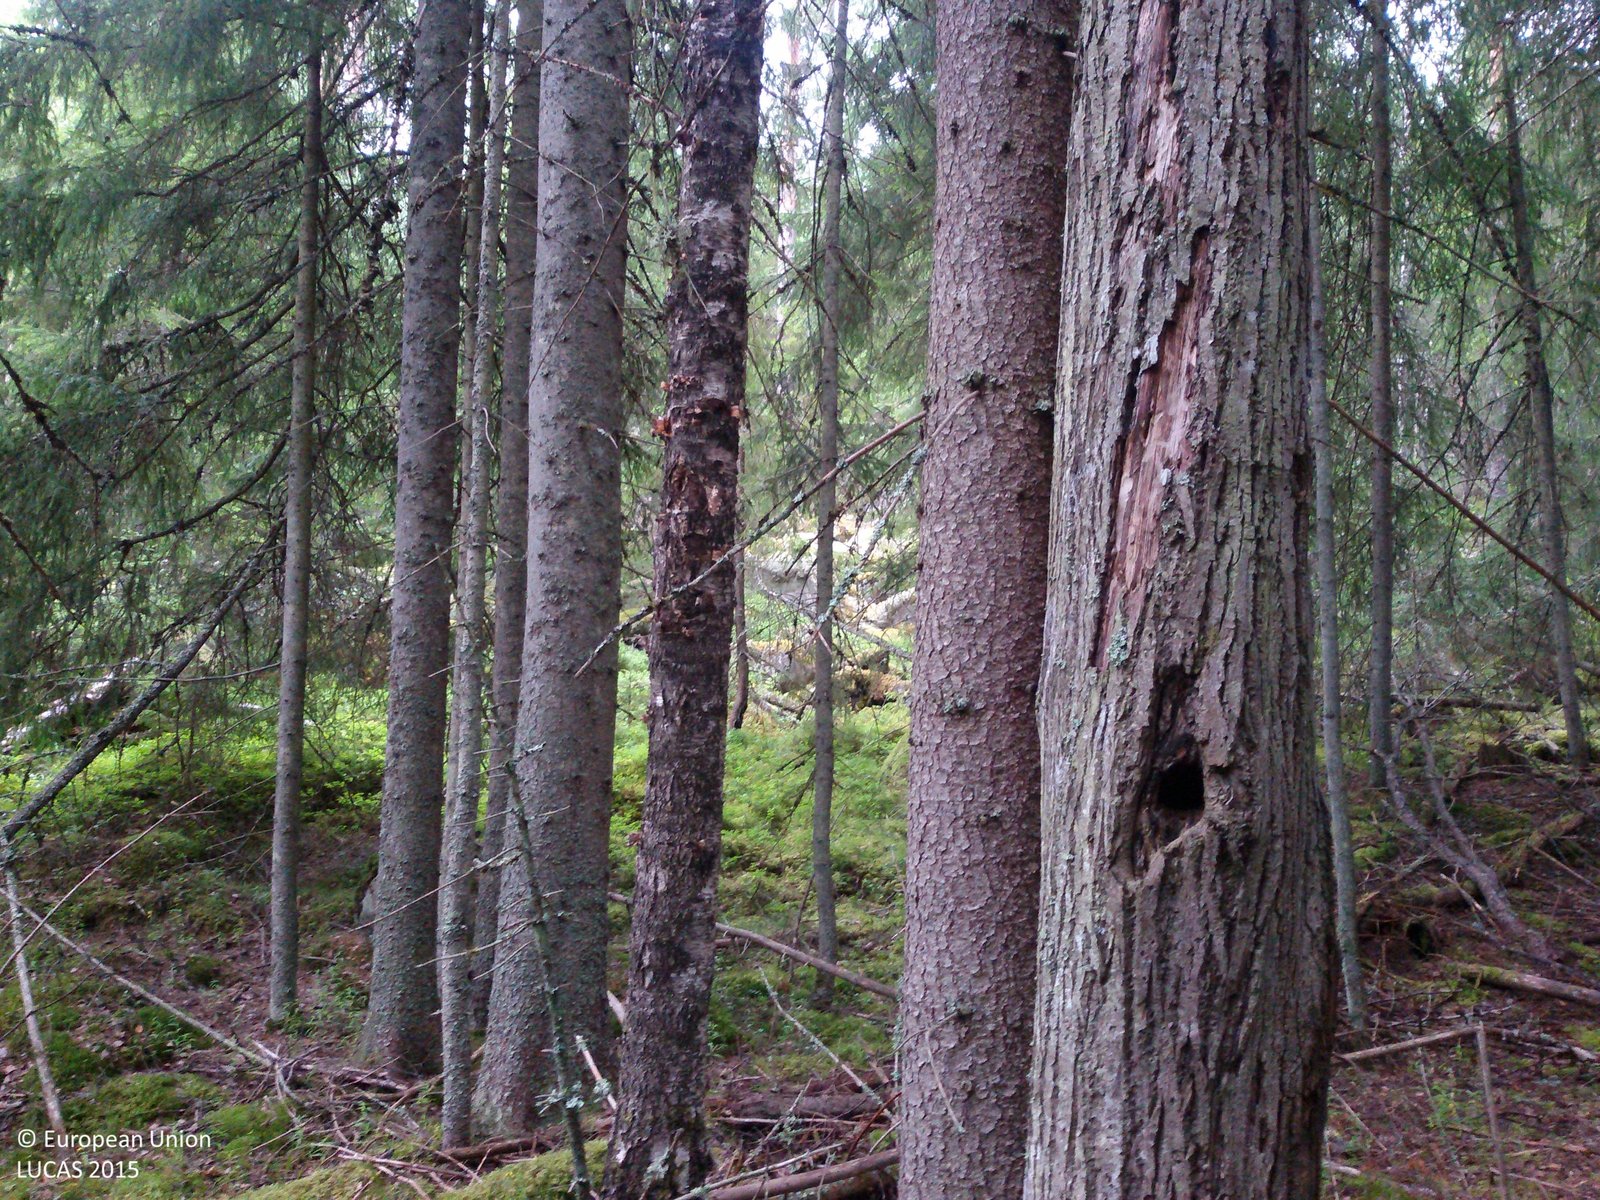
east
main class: Woodland
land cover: Spruce dominated coniferous woodland
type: boreal forest
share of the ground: > 75 %
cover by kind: coniferous forest trees 80 %, herbaceous plants 20 %
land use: Forestry
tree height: > 5 m
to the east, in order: Spruce dominated coniferous woodland; Pine dominated mixed woodland; Spruce dominated mixed woodland; Pine dominated mixed woodland; Spruce dominated coniferous woodland; Pine dominated coniferous woodland
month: July
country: SE
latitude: 60.5996
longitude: 15.8860
